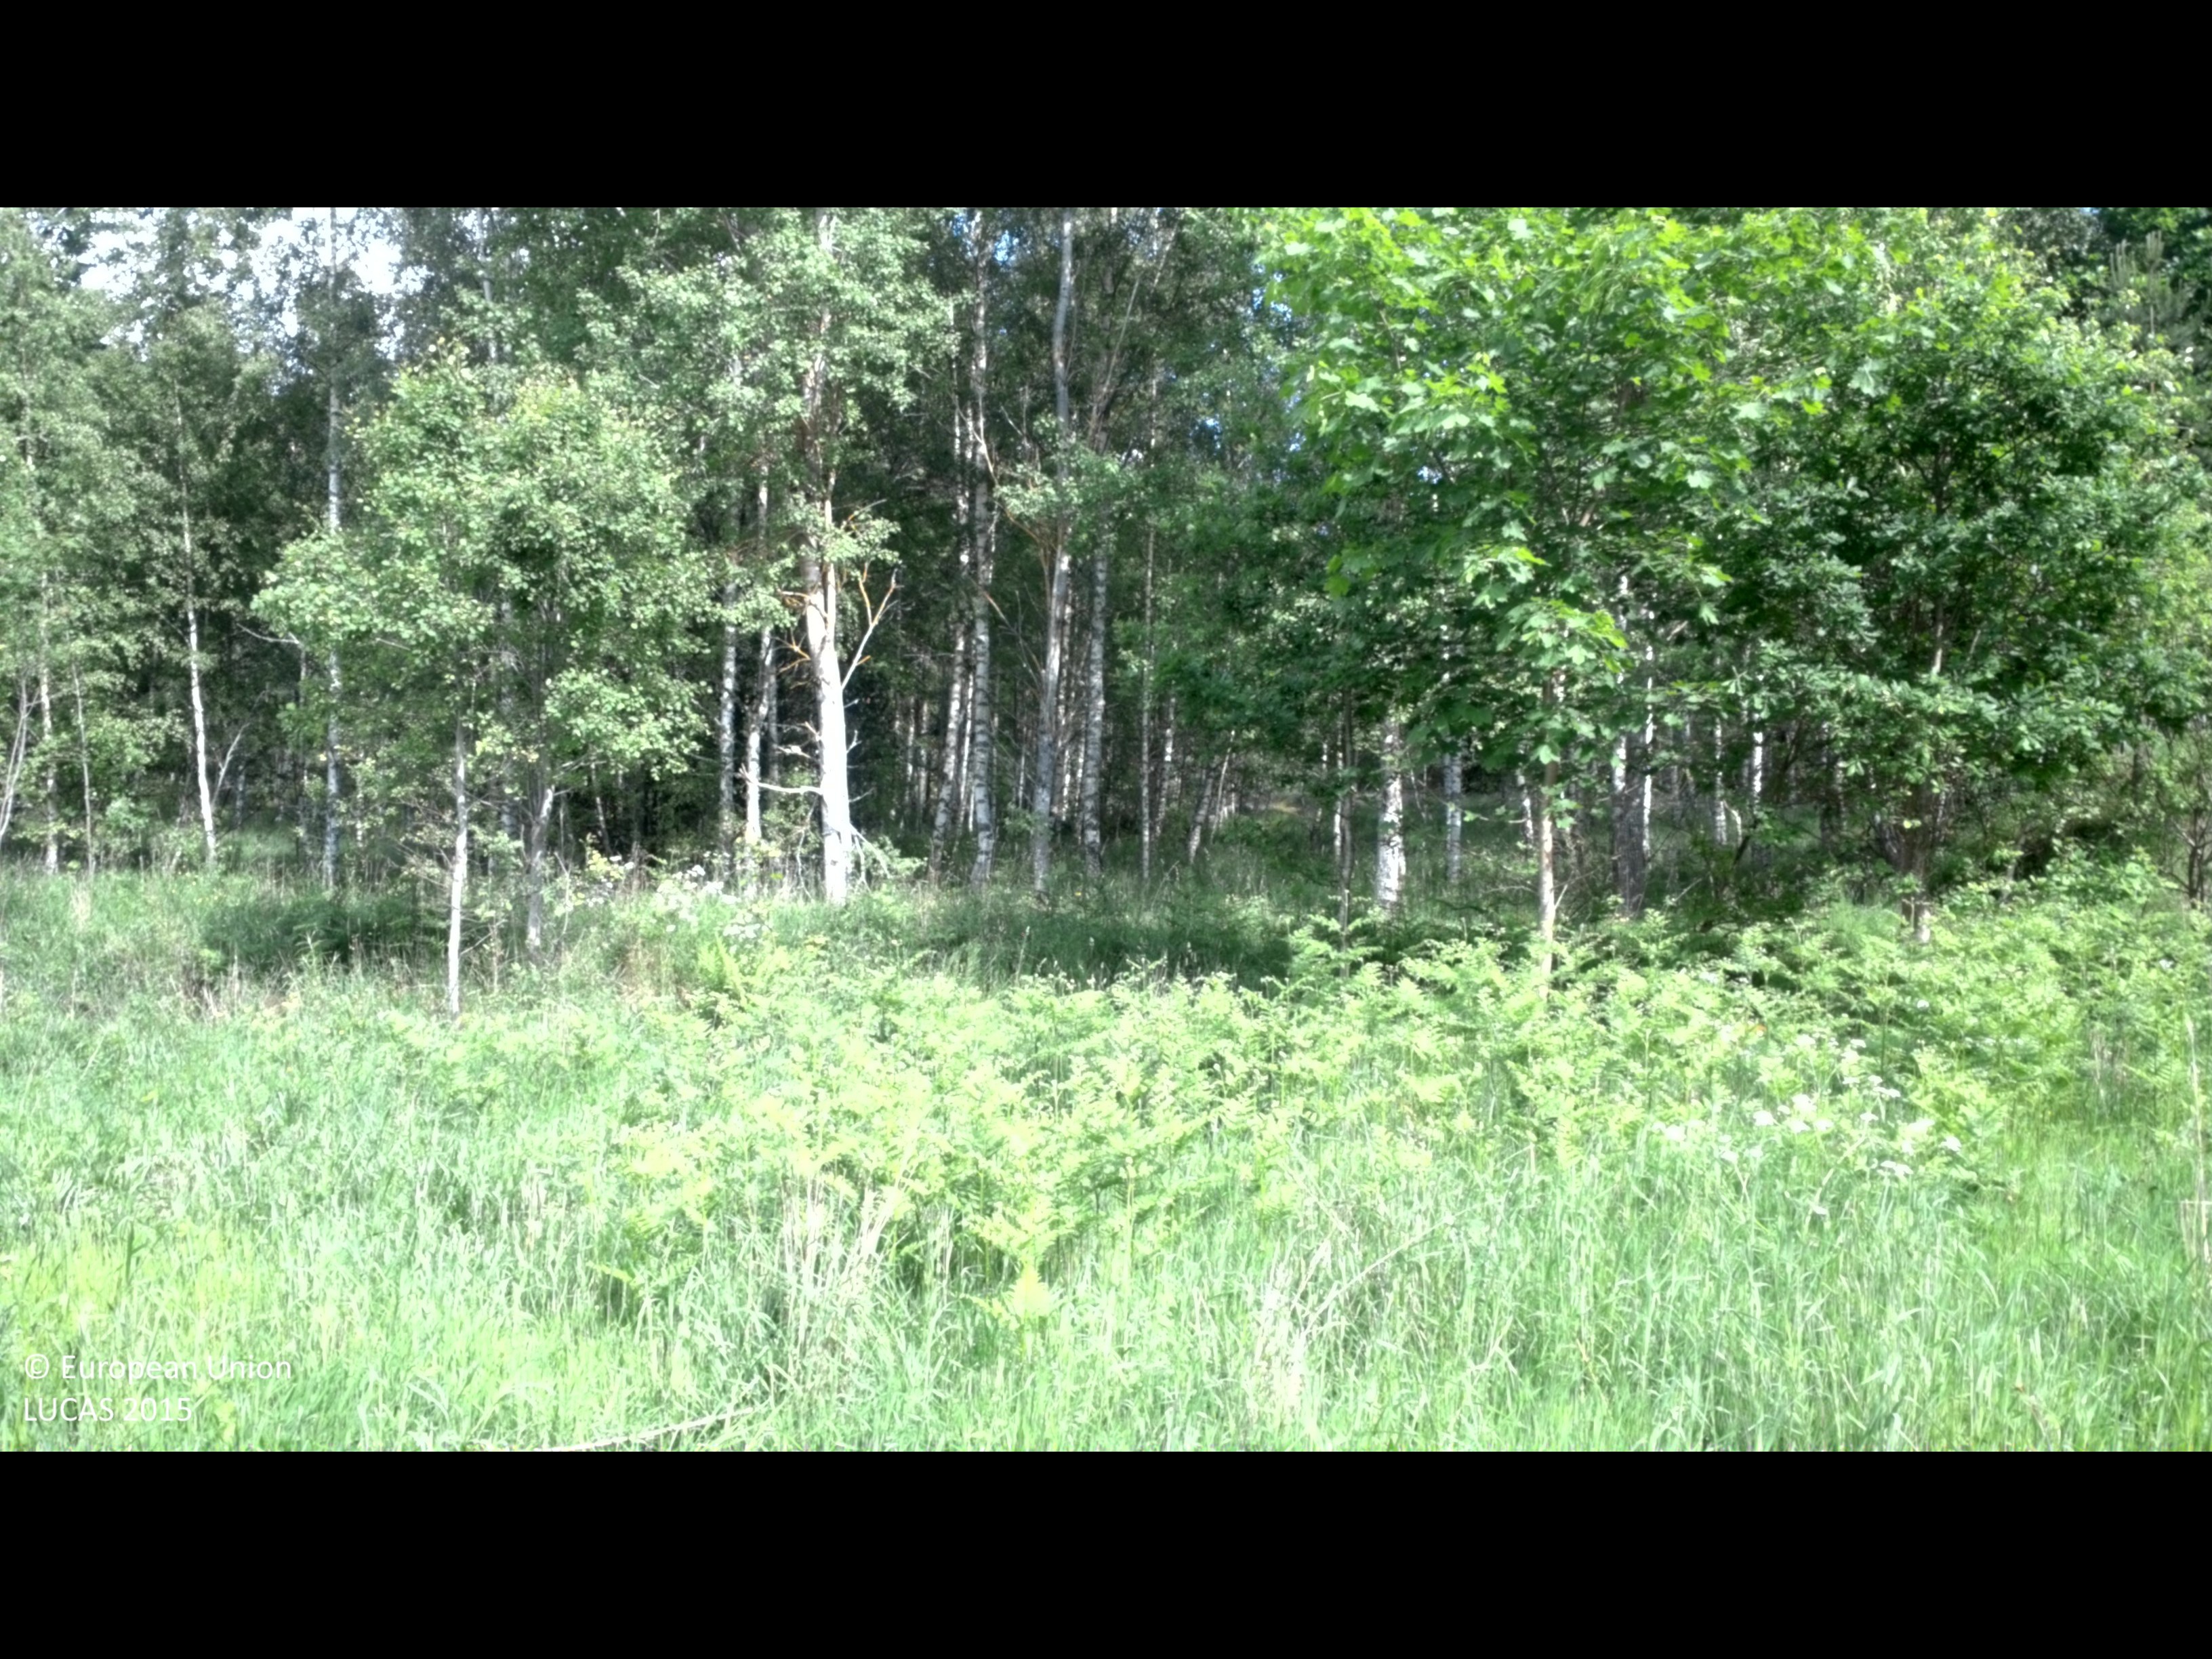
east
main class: Cropland
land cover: Permanent industrial crops
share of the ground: 25 - 50 %
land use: Agriculture (excluding fallow land and kitchen gardens)
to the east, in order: Permanent industrial crops; Spontaneously vegetated surfaces; Ditches and canals; Abandoned hedges; Grass margins; Tracks; Grass margins; Broadleaved woodland; Ditches and canals; Broadleaved woodland; Grass margins; Paved roads, cycling and walking lanes; Ditches and canals; Pine dominated mixed woodland; Electric lines; Pine dominated mixed woodland; Spruce dominated coniferous woodland
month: June
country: SE
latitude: 57.7520
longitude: 16.5687
